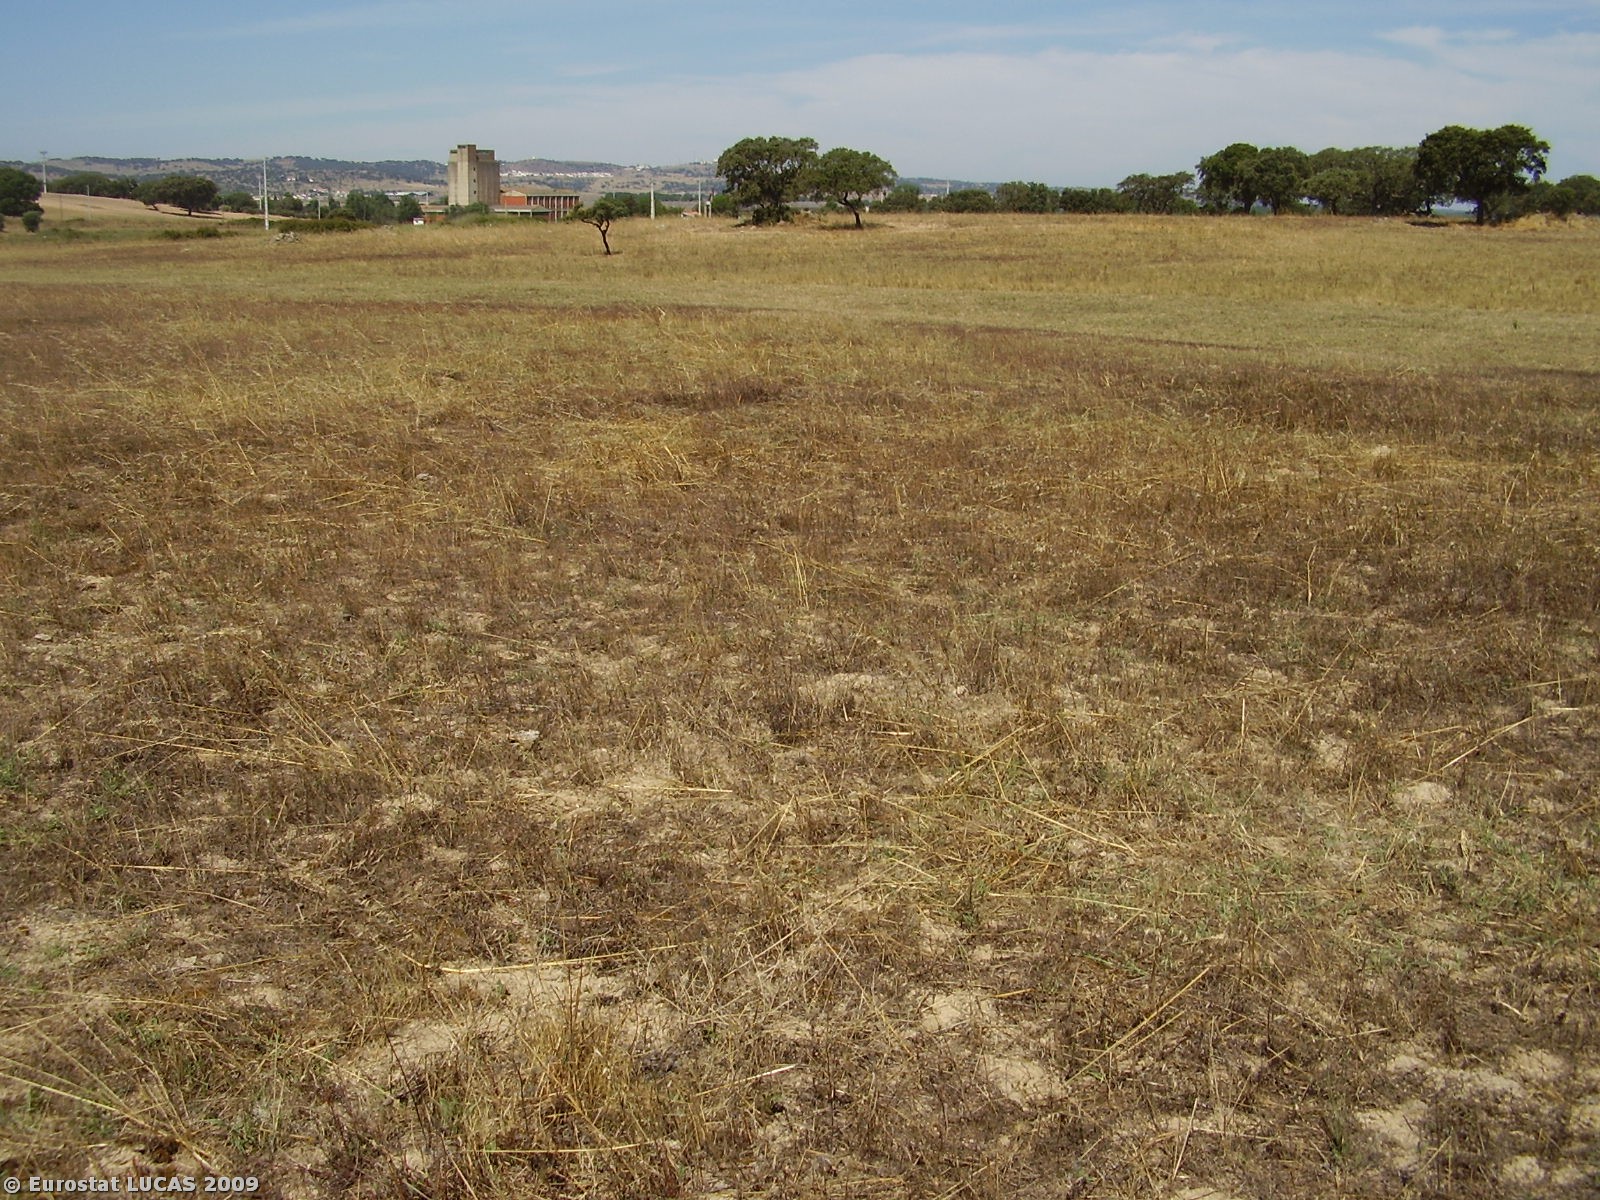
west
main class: Grassland
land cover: Grassland without tree/shrub cover
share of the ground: > 75 %
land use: Fallow land
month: July
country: PT
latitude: 38.7162
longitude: -7.9030
